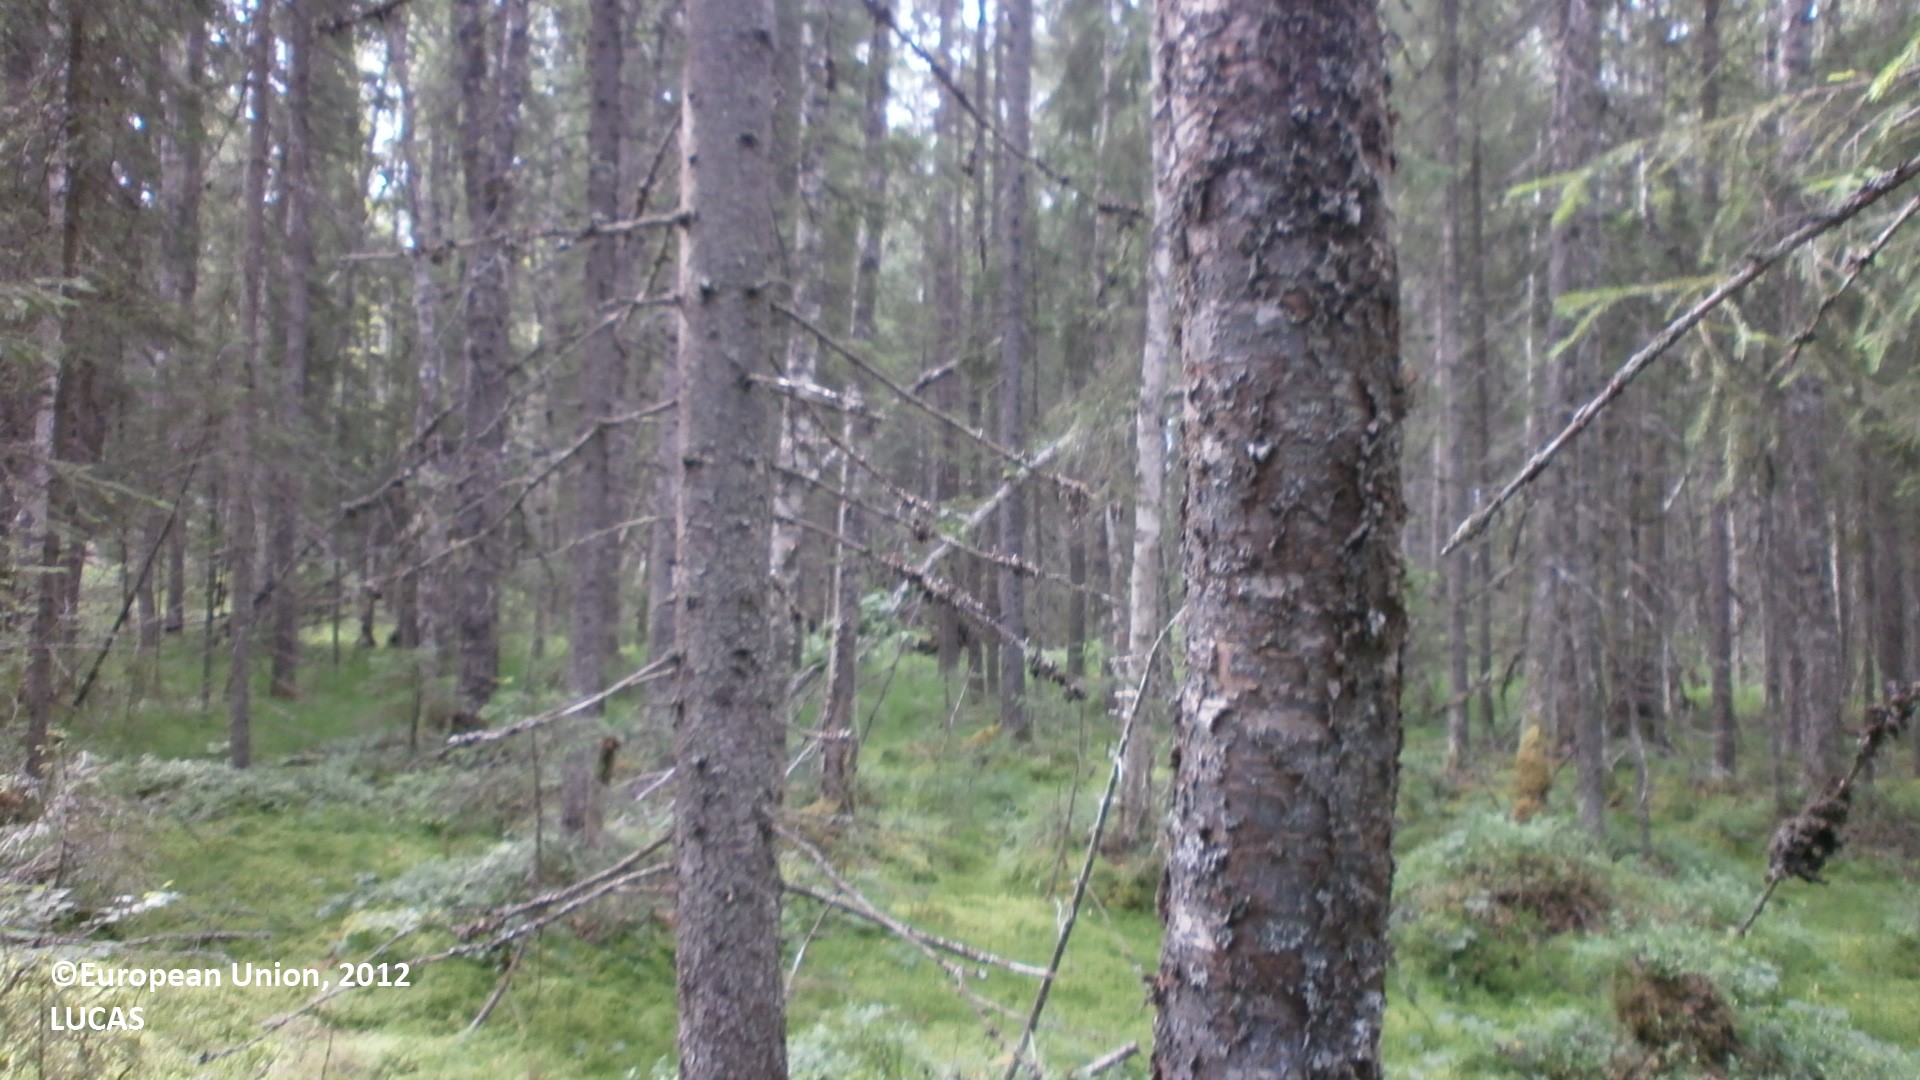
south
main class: Woodland
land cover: Spruce dominated mixed woodland
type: boreal forest
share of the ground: > 75 %
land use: Forestry
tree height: > 5 m
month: July
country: FI
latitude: 64.0768
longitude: 23.9018
